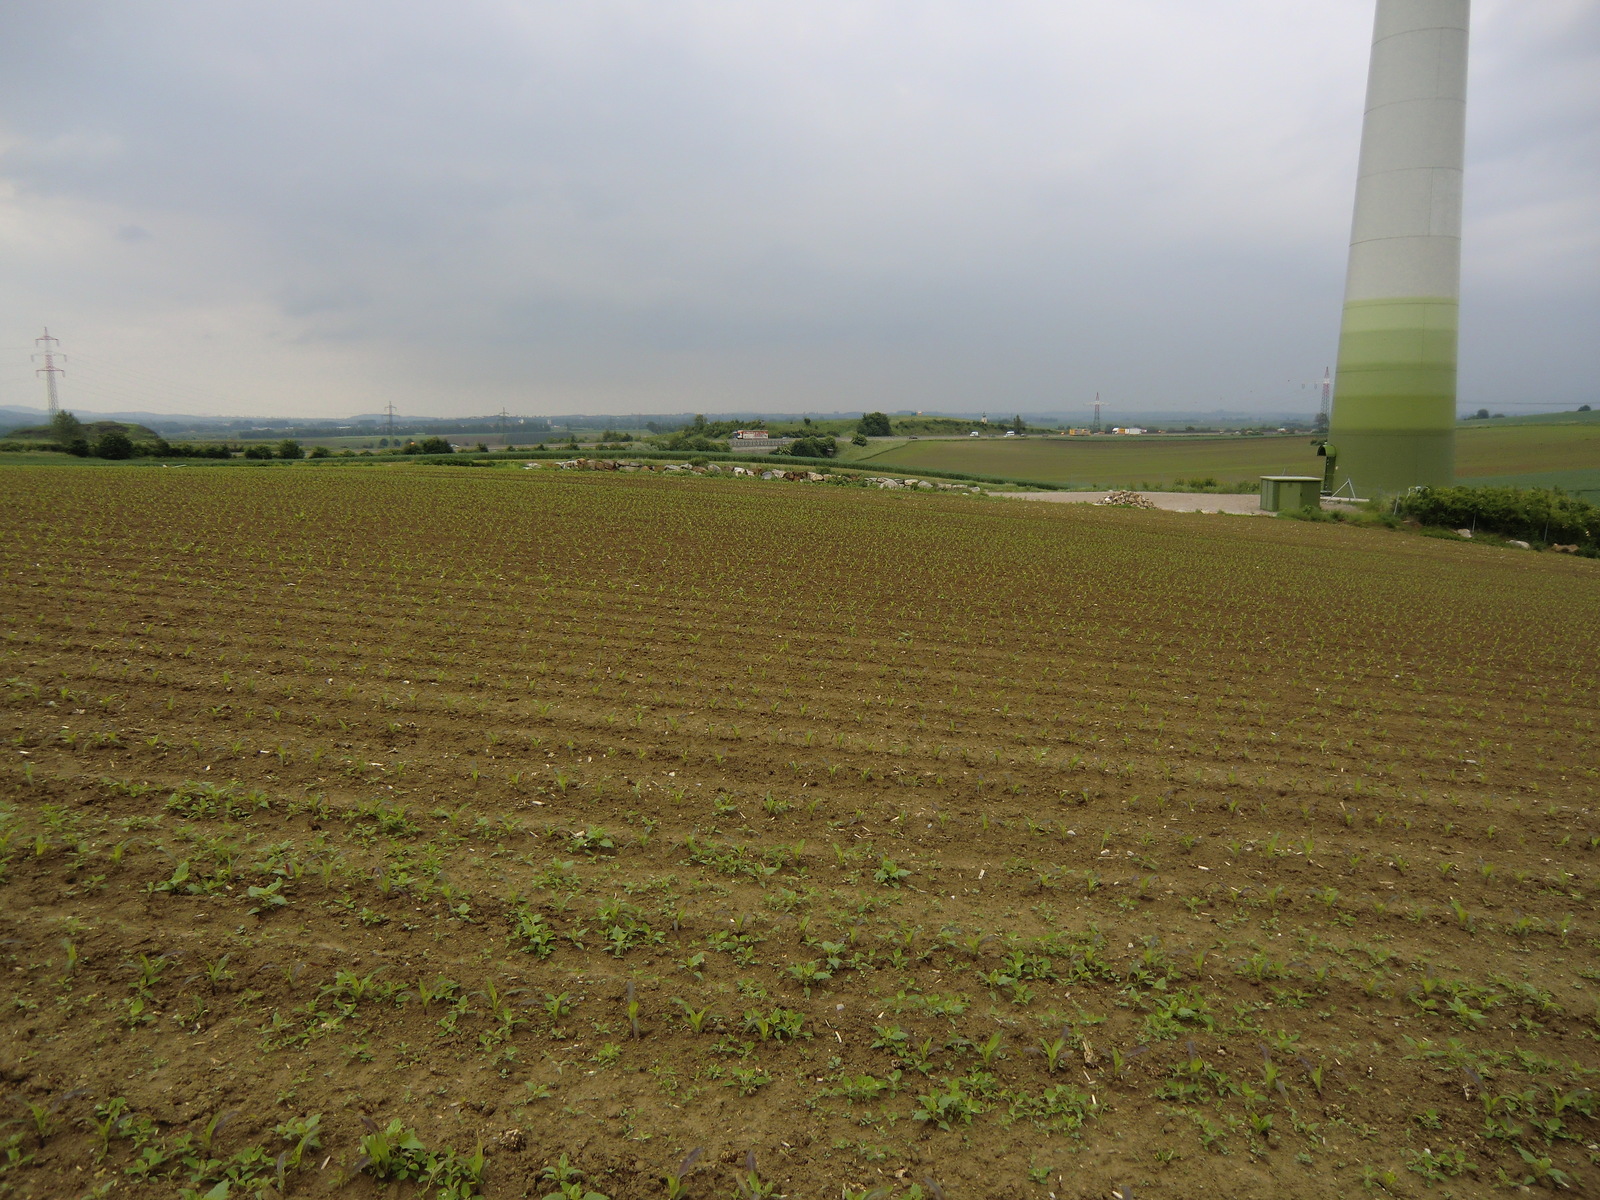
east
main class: Cropland
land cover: Common wheat
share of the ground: > 75 %
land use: Agriculture (excluding fallow land and kitchen gardens)
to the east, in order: Common wheat; Maize; Grass margins; Artificial constructions; Other bare soil; Artificial constructions; Grass margins; Maize; Common wheat; Maize
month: May
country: AT
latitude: 48.1790
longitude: 15.4490
